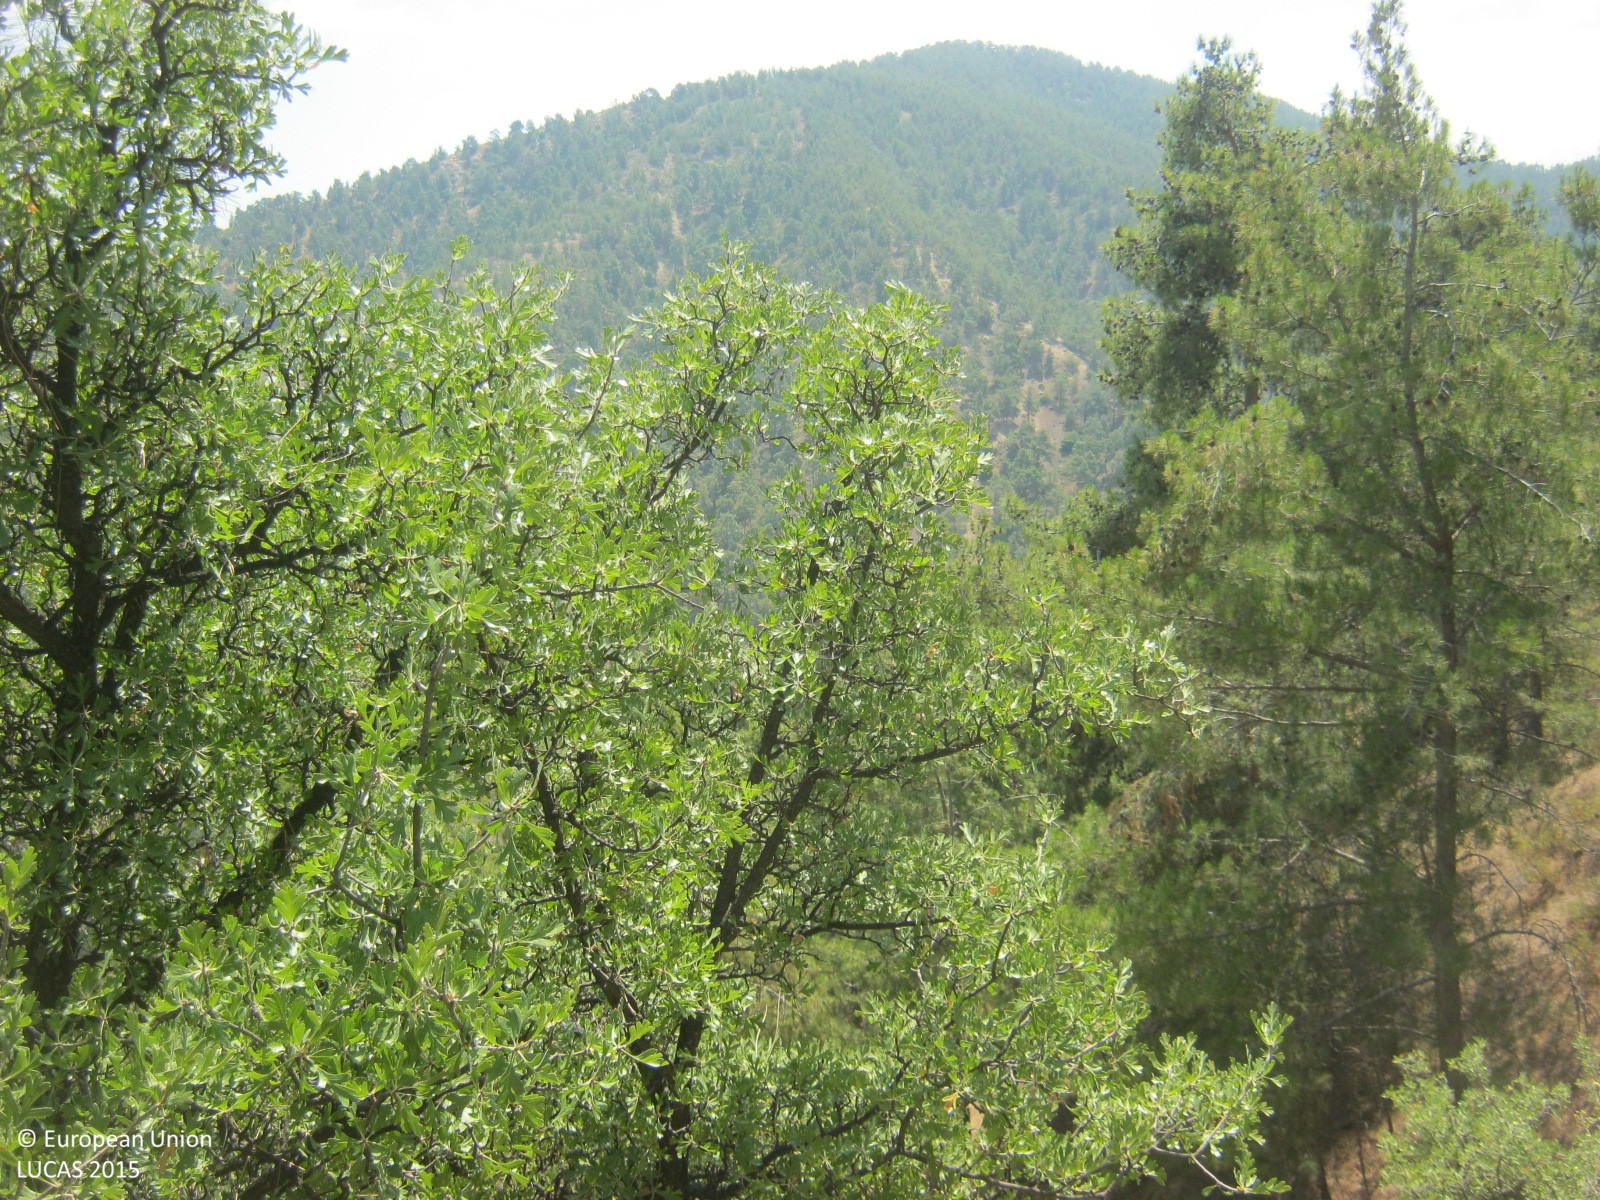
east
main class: Woodland
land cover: Pine dominated coniferous woodland
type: coniferous forest of the mediterranean region
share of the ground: > 75 %
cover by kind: coniferous forest trees 80 %, shrubs 10 %, unconsolidated bare surface 10 %
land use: Forestry
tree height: > 5 m
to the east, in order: Pine dominated coniferous woodland; Paved roads, cycling and walking lanes; Pine dominated coniferous woodland
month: June
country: CY
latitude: 35.0183
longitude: 33.0026
